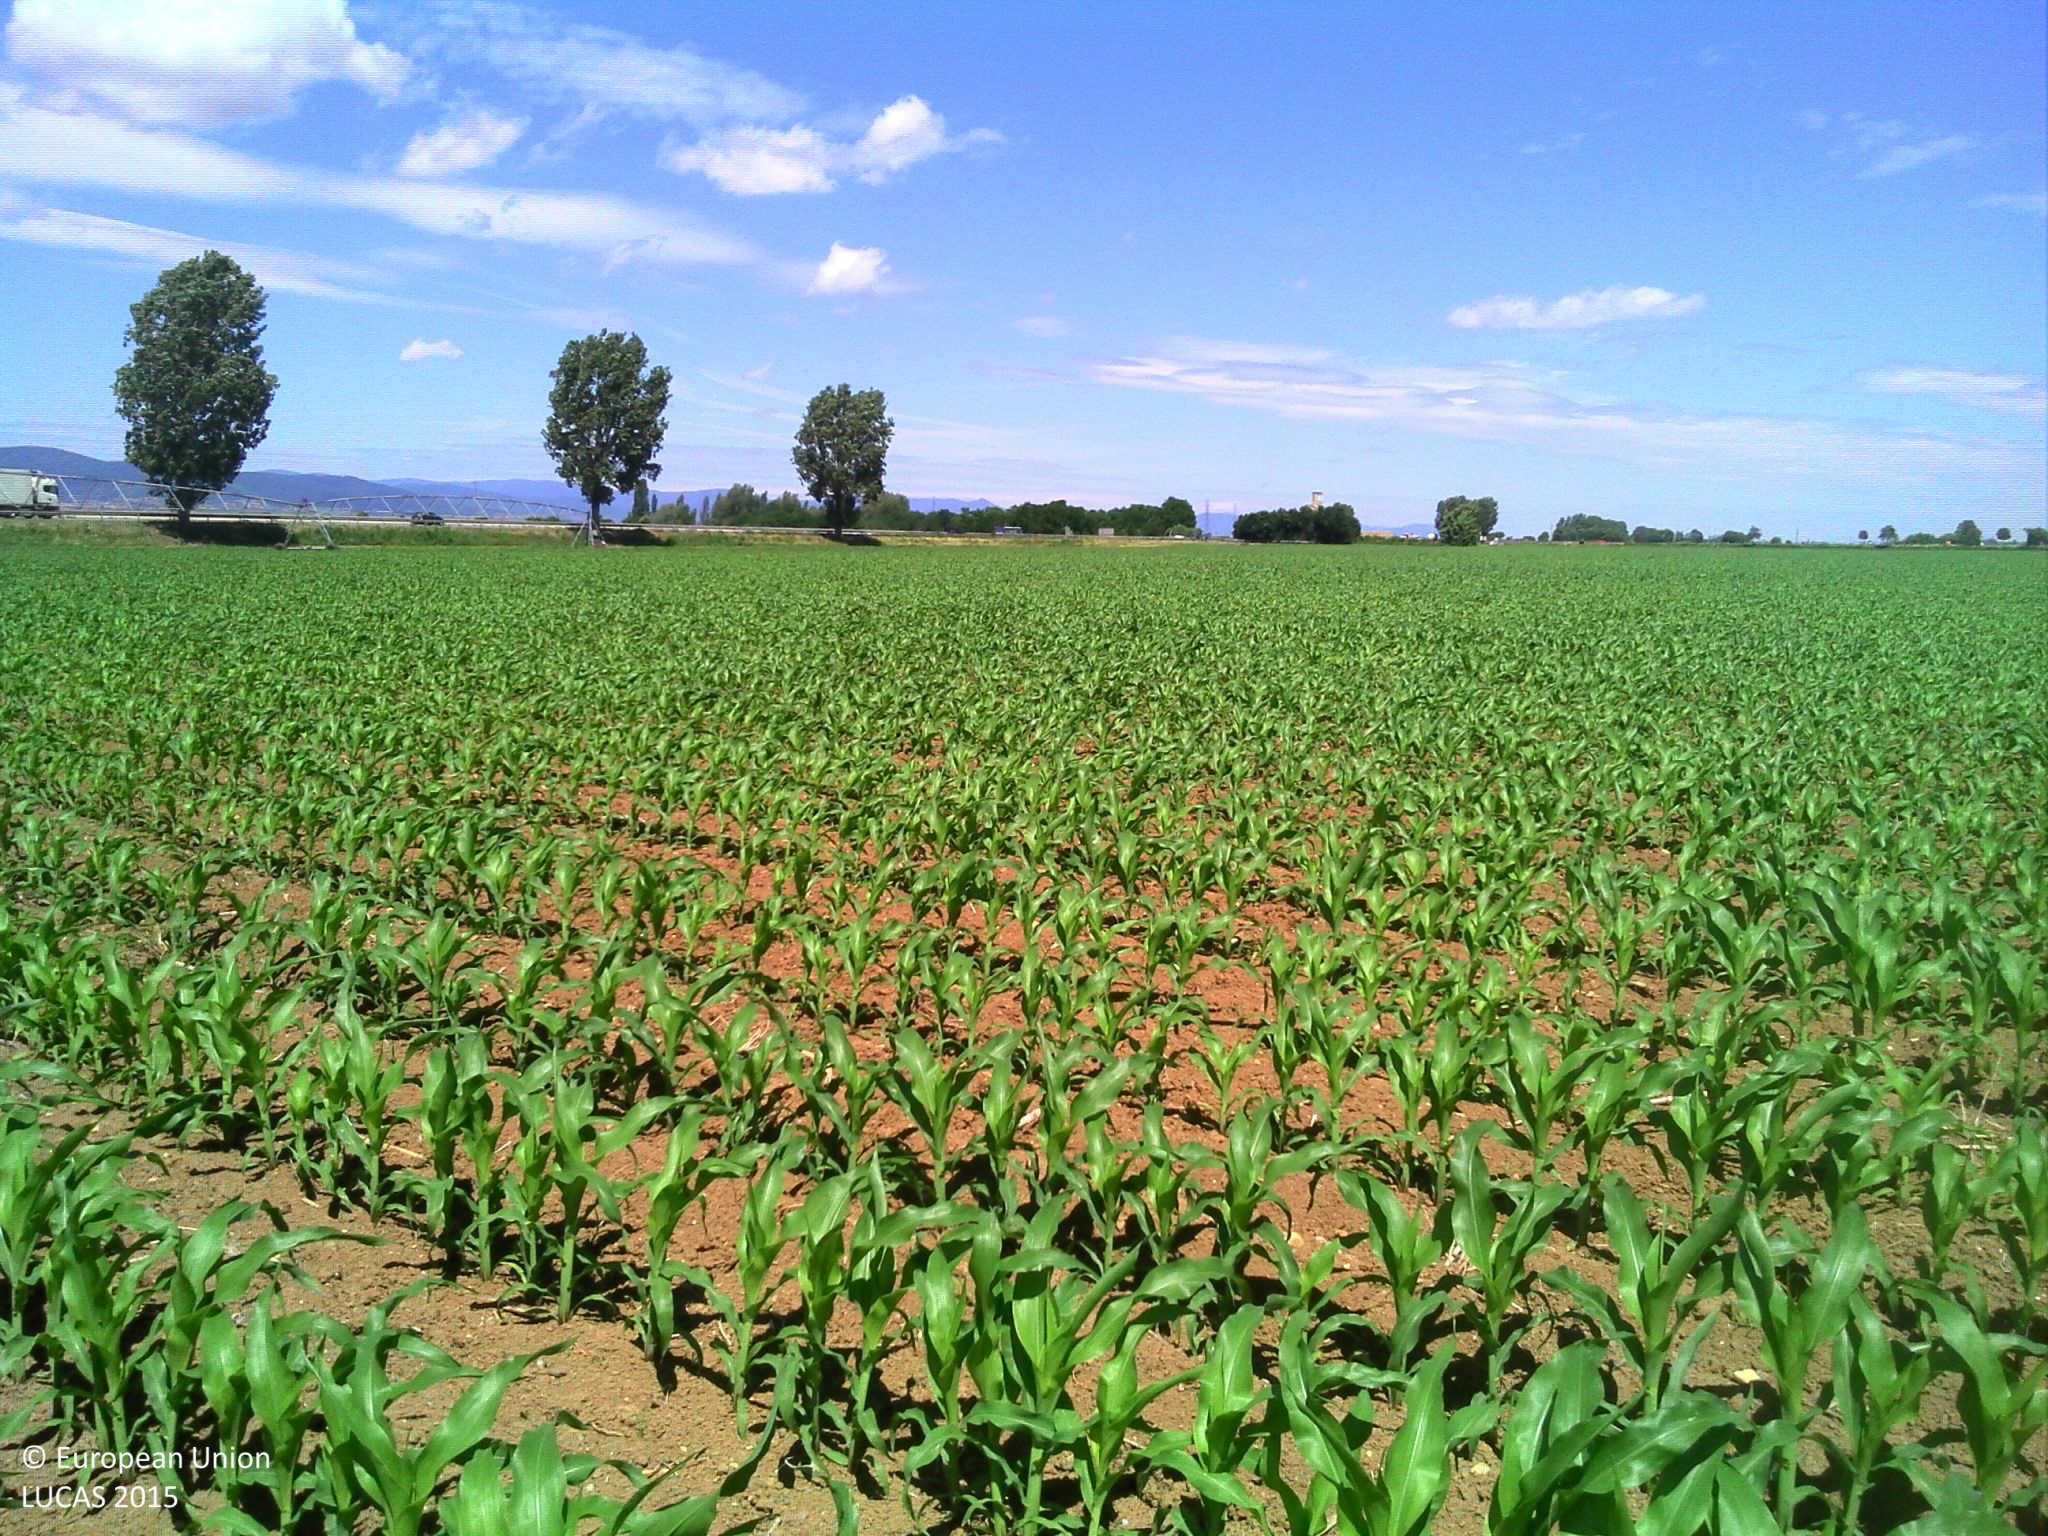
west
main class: Cropland
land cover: Maize
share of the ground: 25 - 50 %
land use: Agriculture (excluding fallow land and kitchen gardens)
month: June
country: FR
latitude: 47.9400
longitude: 7.3640
